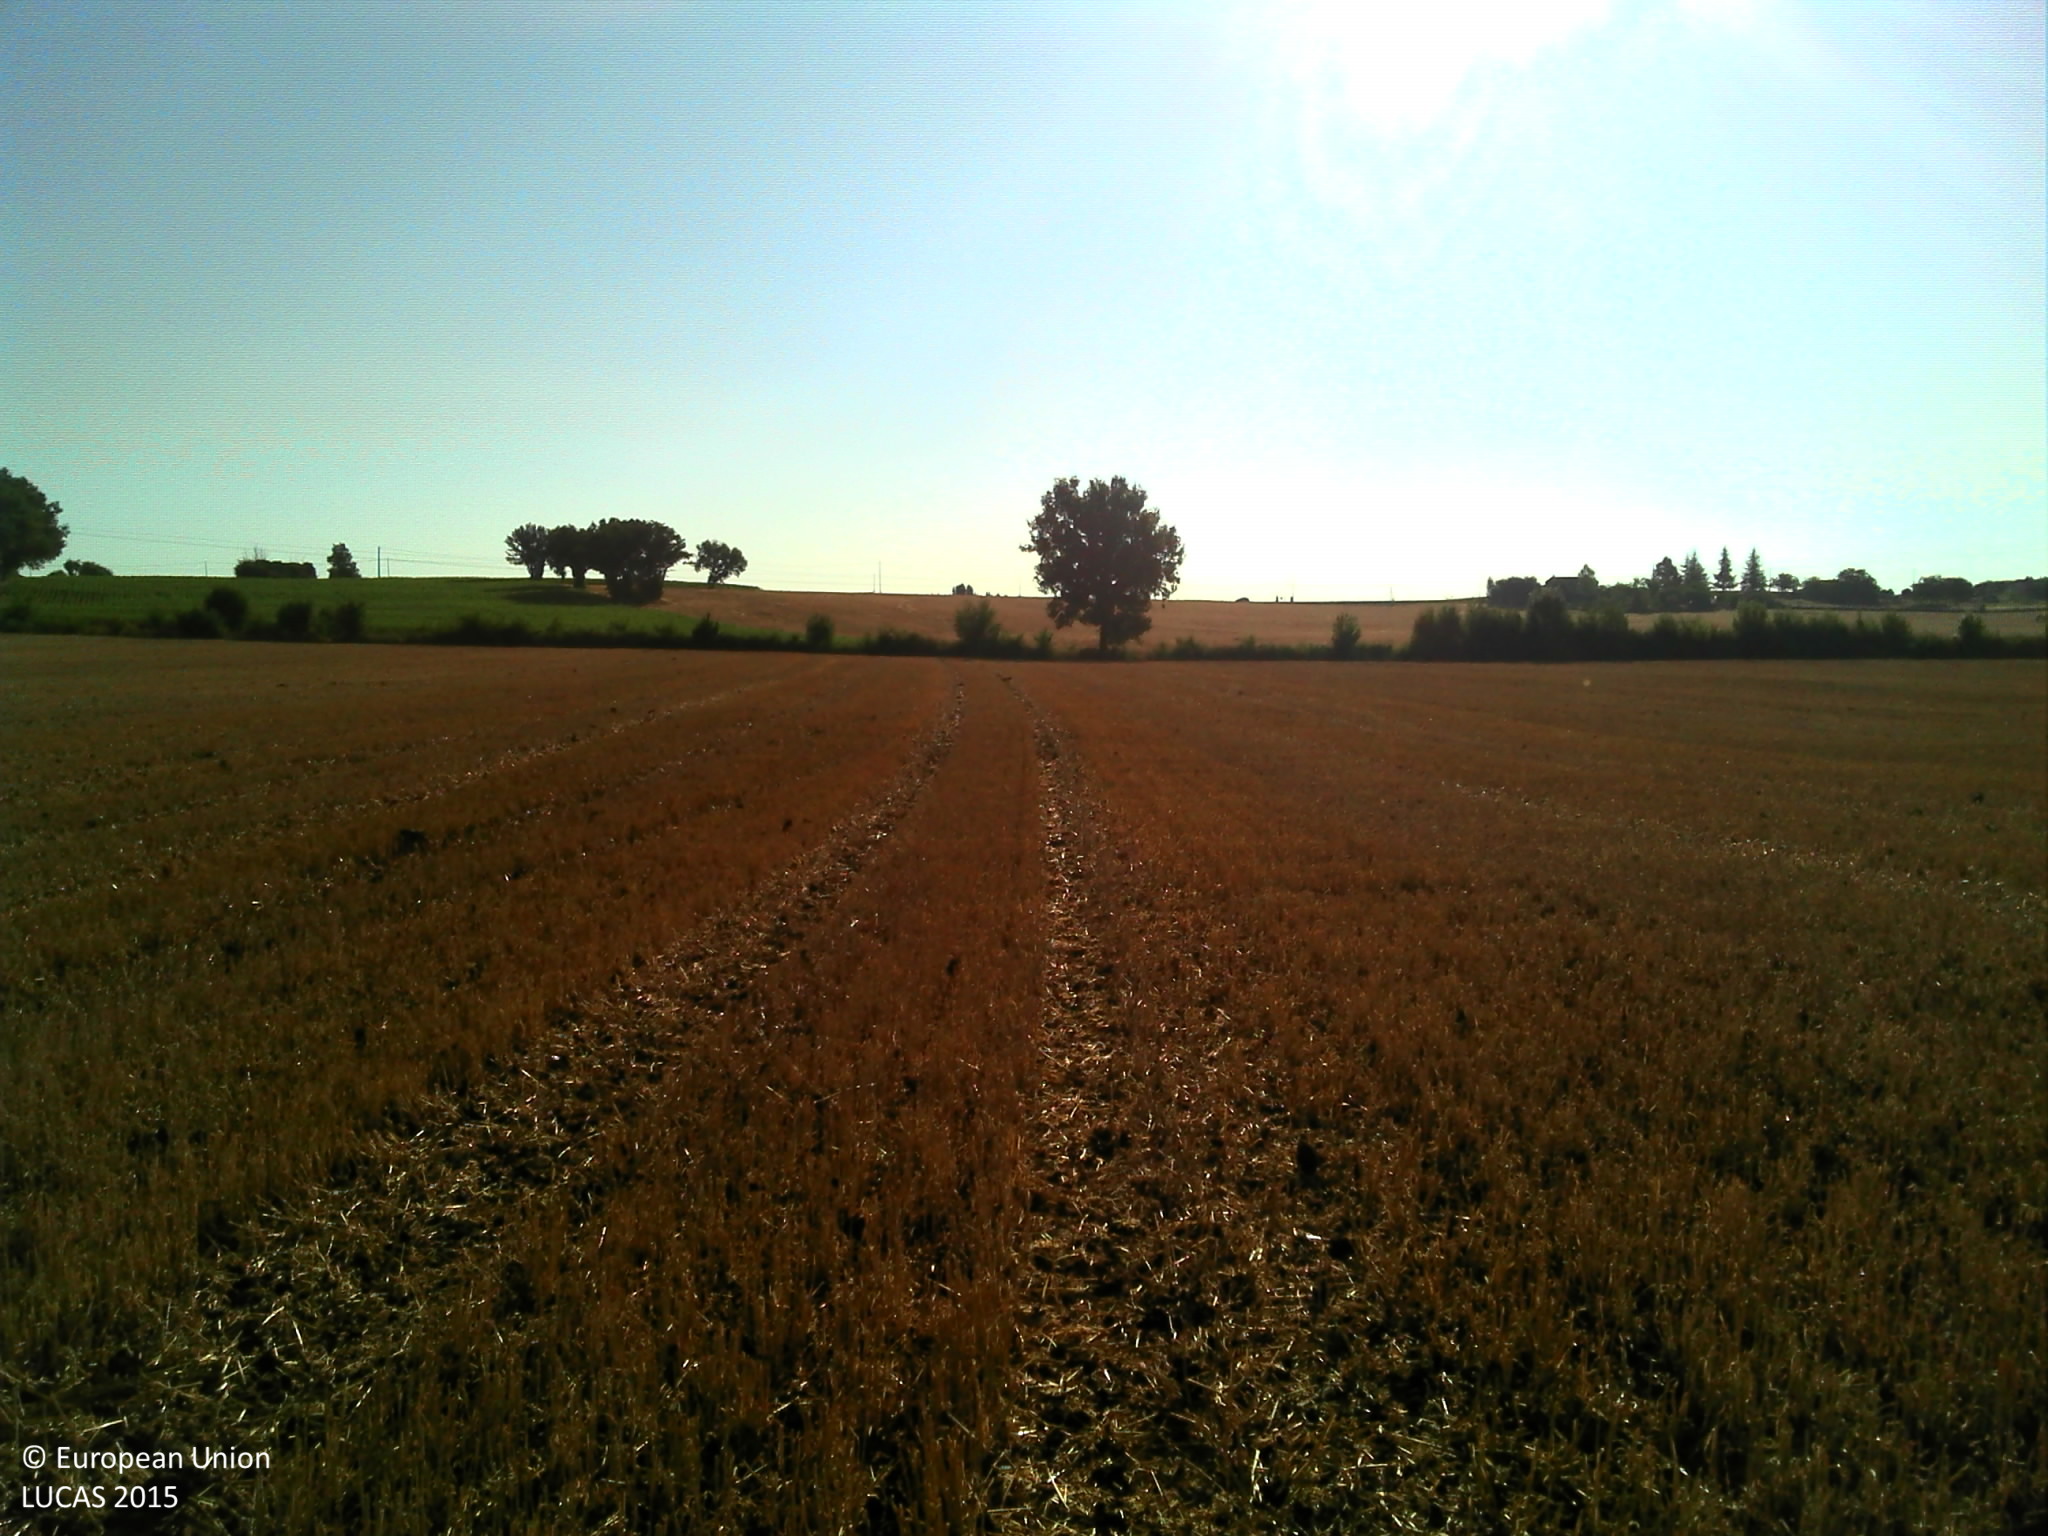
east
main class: Cropland
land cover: Common wheat
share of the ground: > 75 %
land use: Agriculture (excluding fallow land and kitchen gardens)
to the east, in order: Common wheat; Ditches and canals; Managed hedges; Tracks; Grass margins; Ditches and canals; Barley
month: July
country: FR
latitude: 44.5951
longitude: 0.6073
